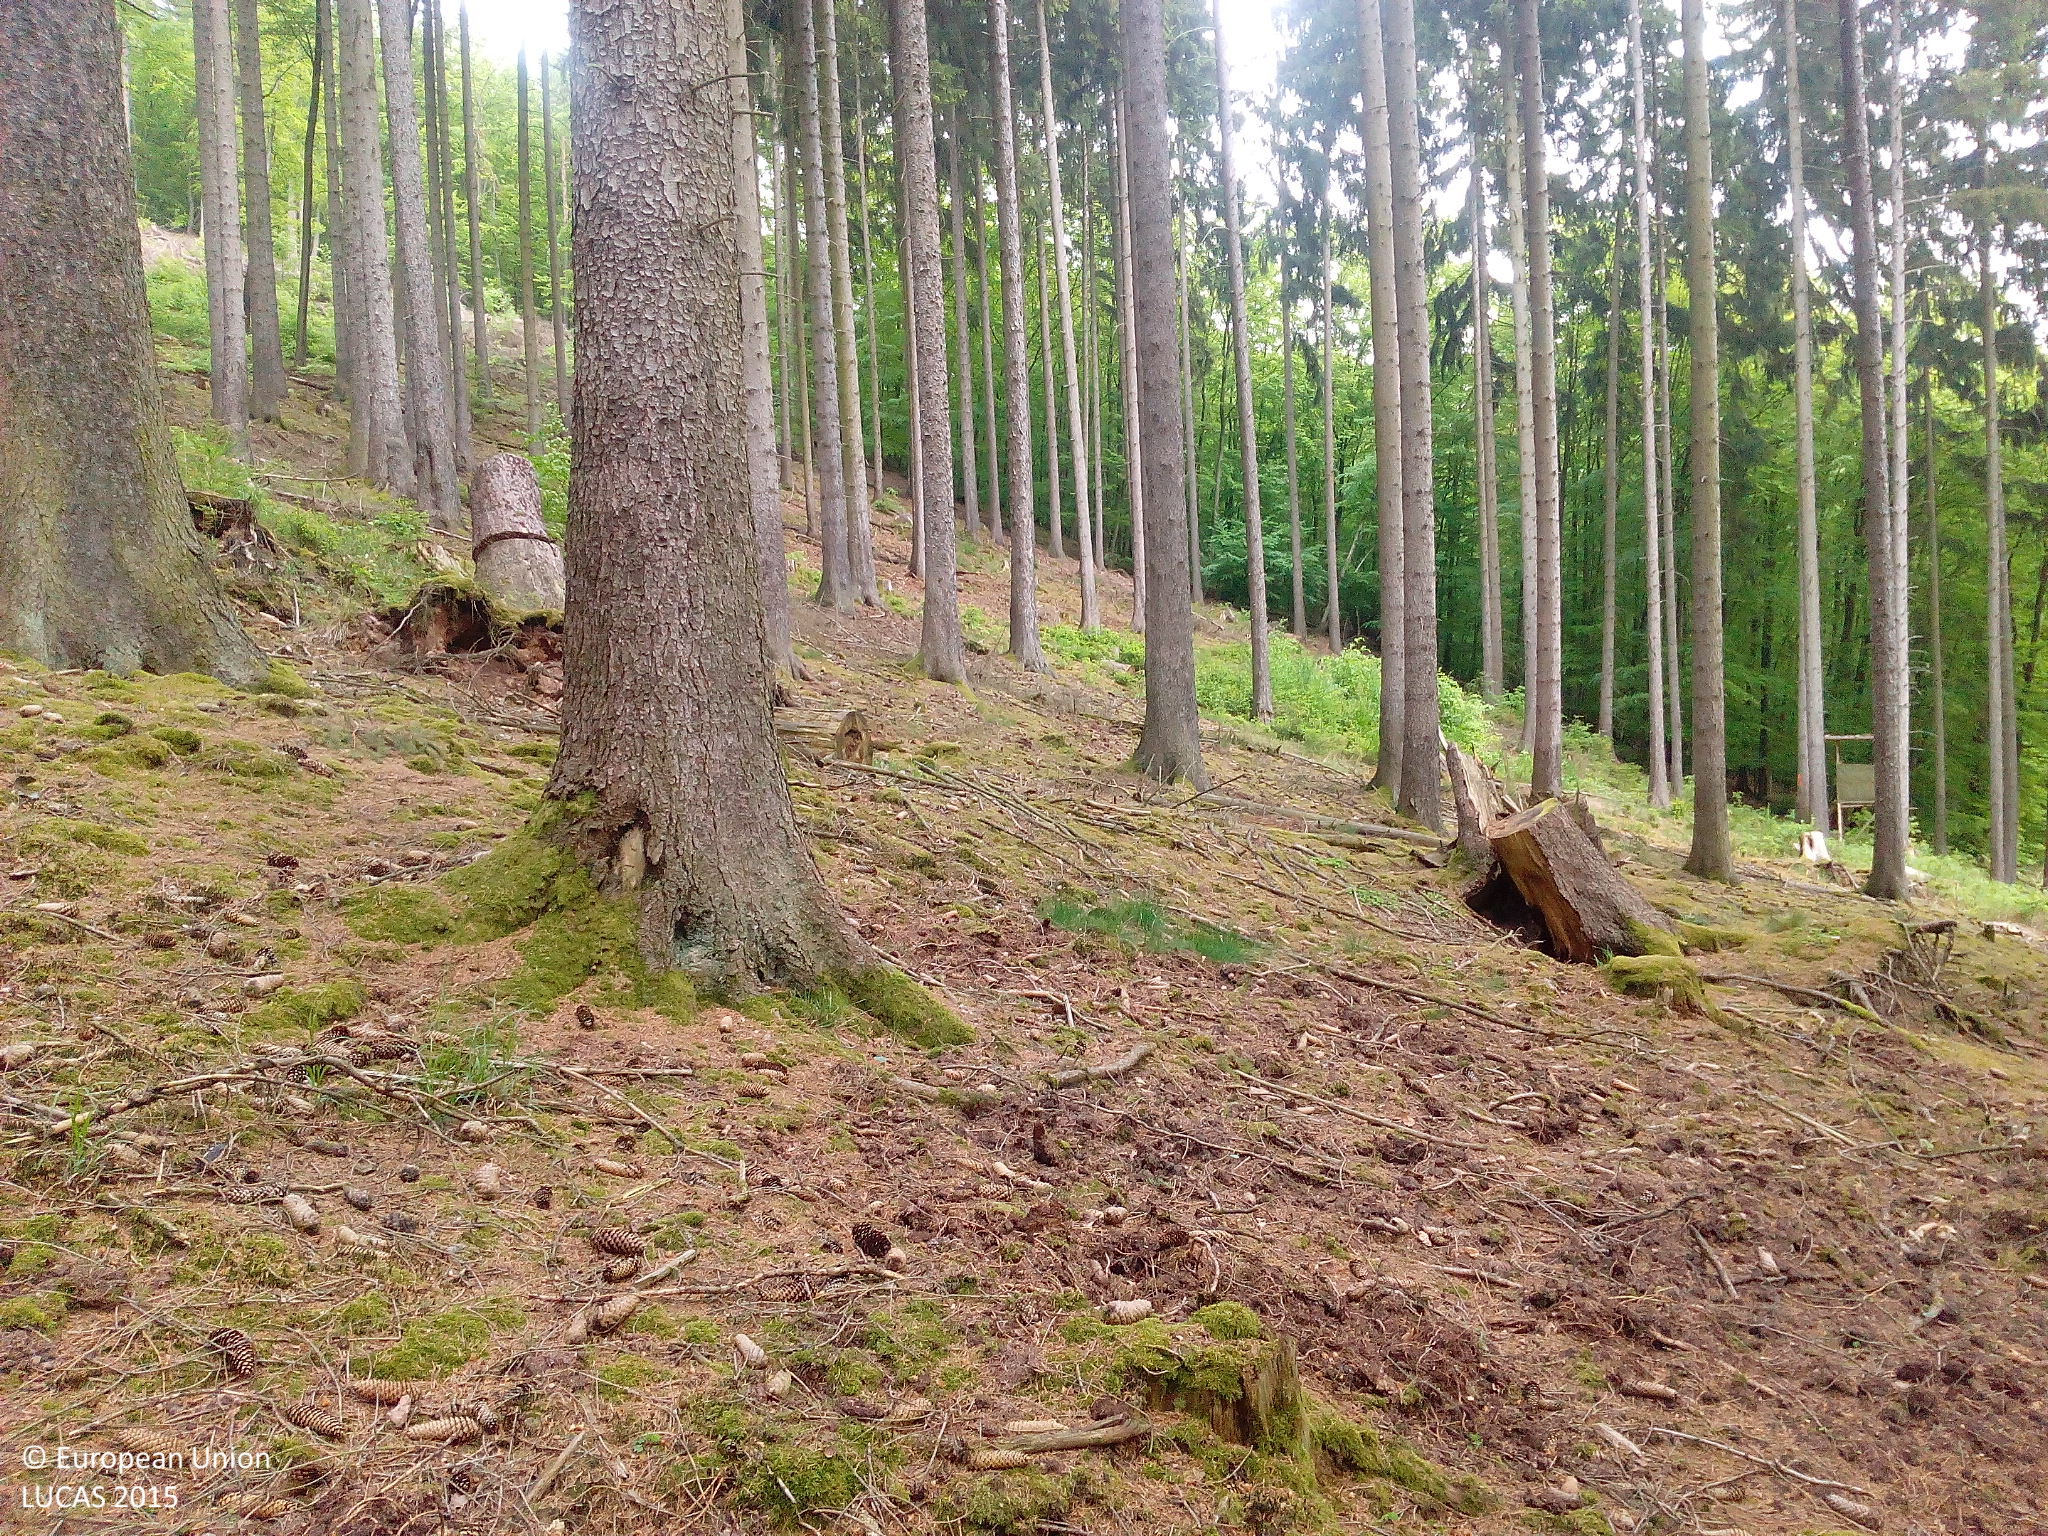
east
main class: Woodland
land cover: Spruce dominated coniferous woodland
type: hemiboreal forest and nemoral coniferous forest and mixed broadleaved-coniferous forest
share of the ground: > 75 %
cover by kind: coniferous forest trees 60 %, unconsolidated bare surface 35 %, lichens and mosses 5 %
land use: Forestry
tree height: > 5 m
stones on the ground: < 10 %
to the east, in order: Spruce dominated coniferous woodland; Broadleaved woodland; Tracks
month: May
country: DE
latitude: 51.1910
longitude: 9.8713
